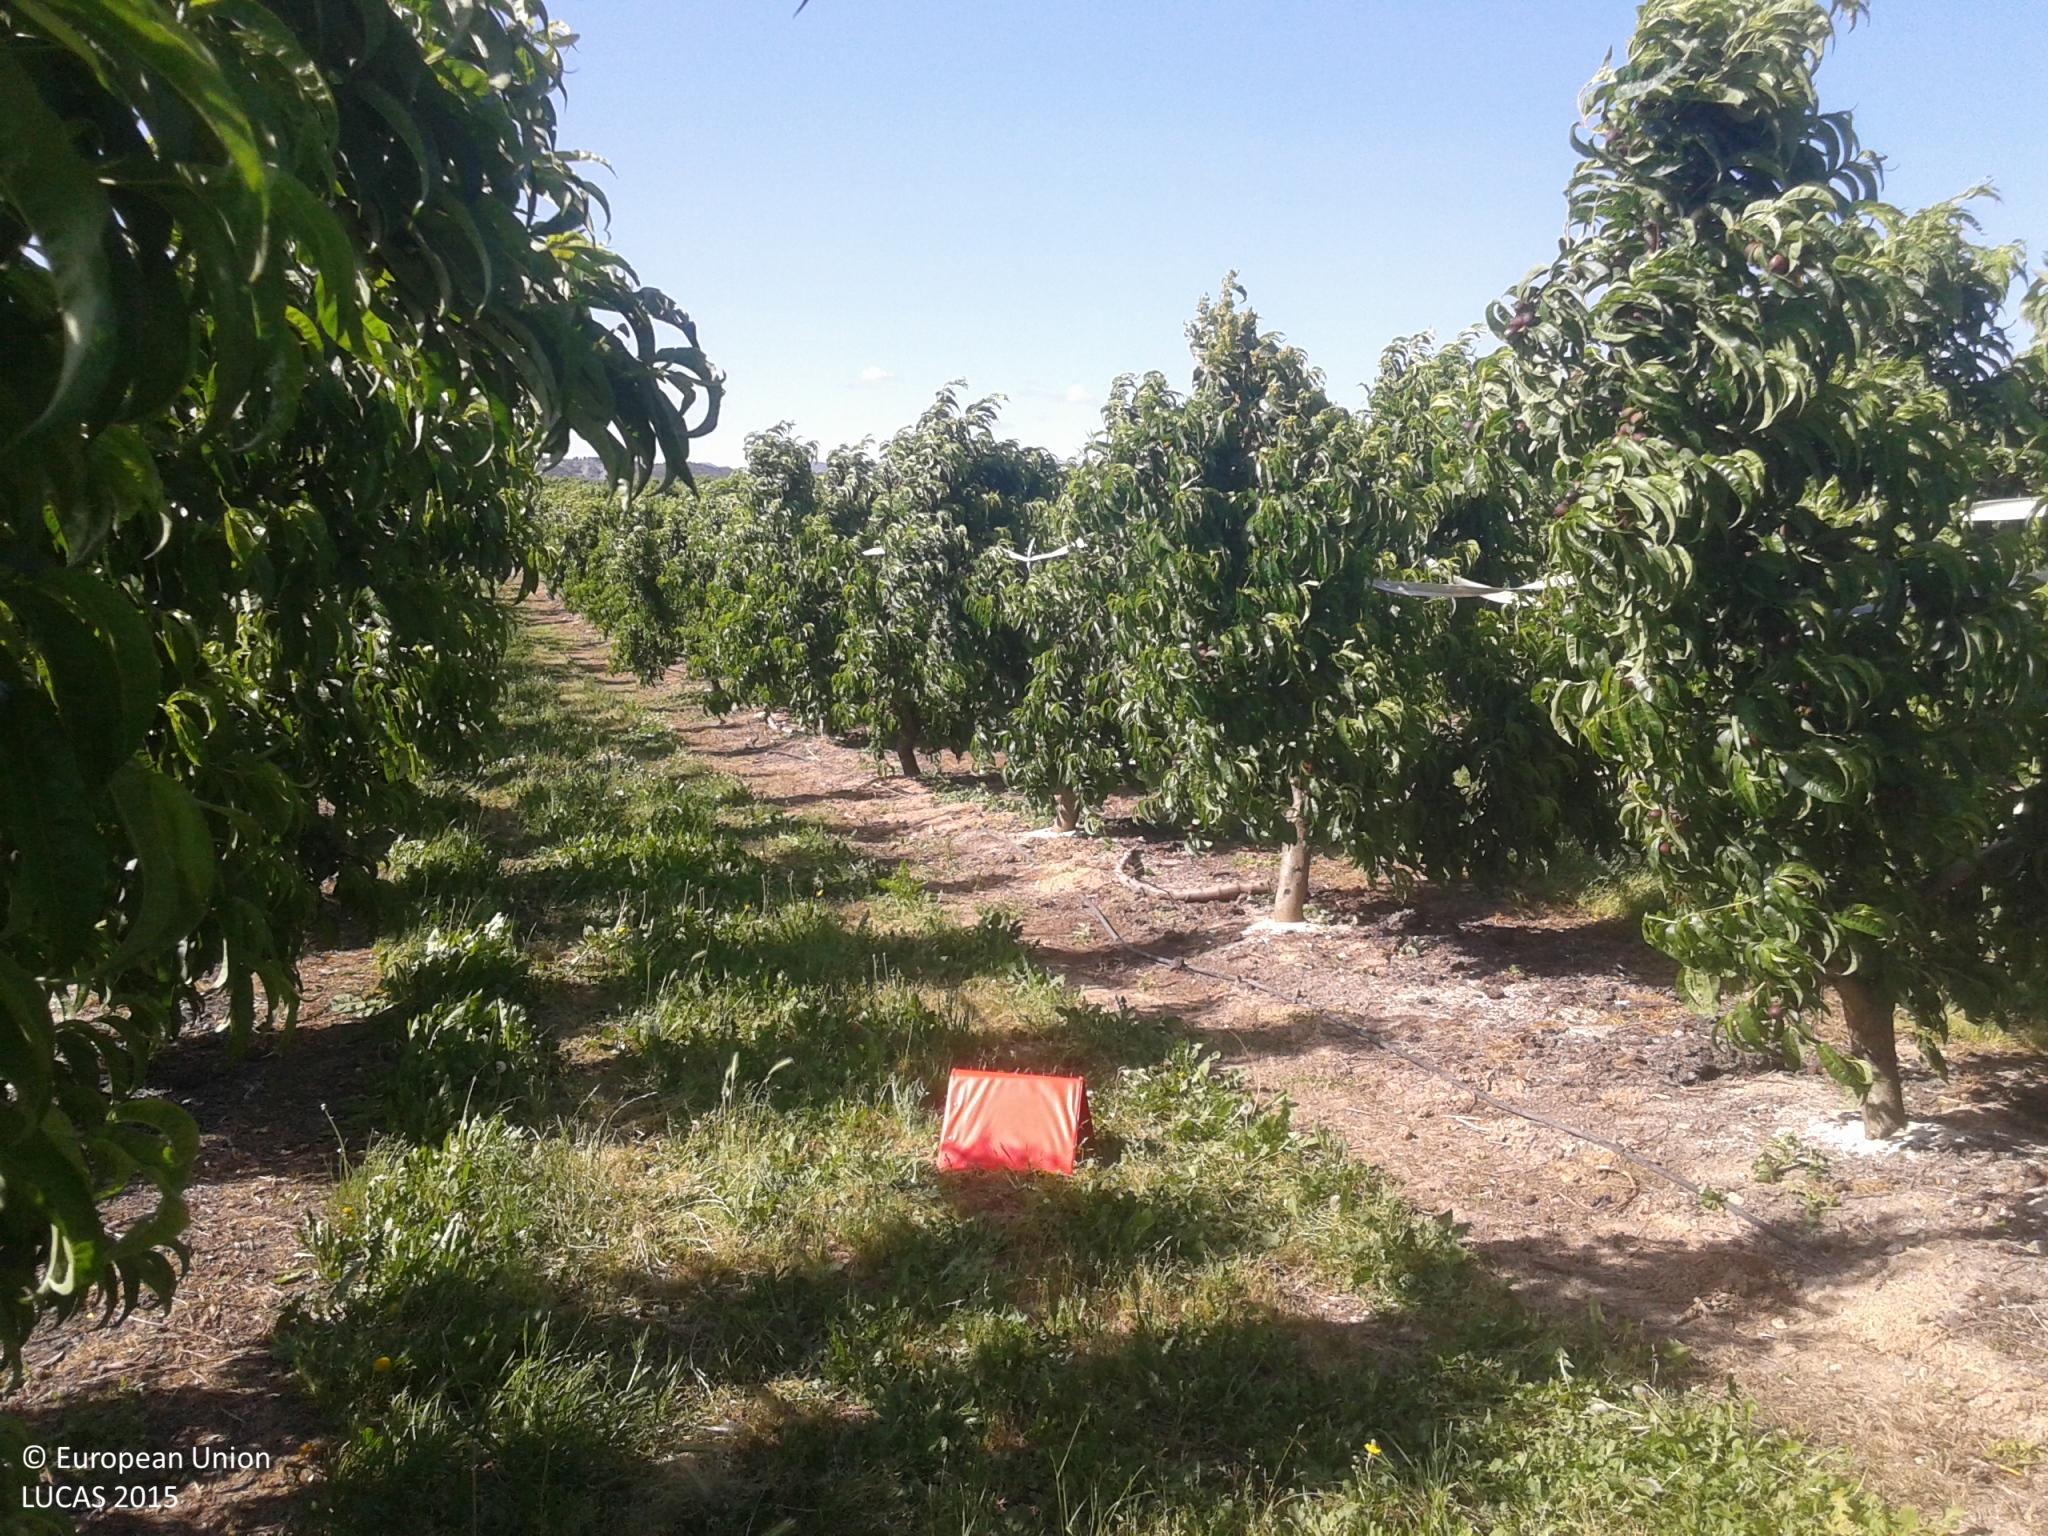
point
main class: Cropland
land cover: Other fruit trees and berries
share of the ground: 25 - 50 %
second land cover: Spontaneously vegetated surfaces
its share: 50 - 75 %
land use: Agriculture (excluding fallow land and kitchen gardens)
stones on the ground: < 10 %
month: May
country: ES
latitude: 41.7856
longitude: 0.6614
